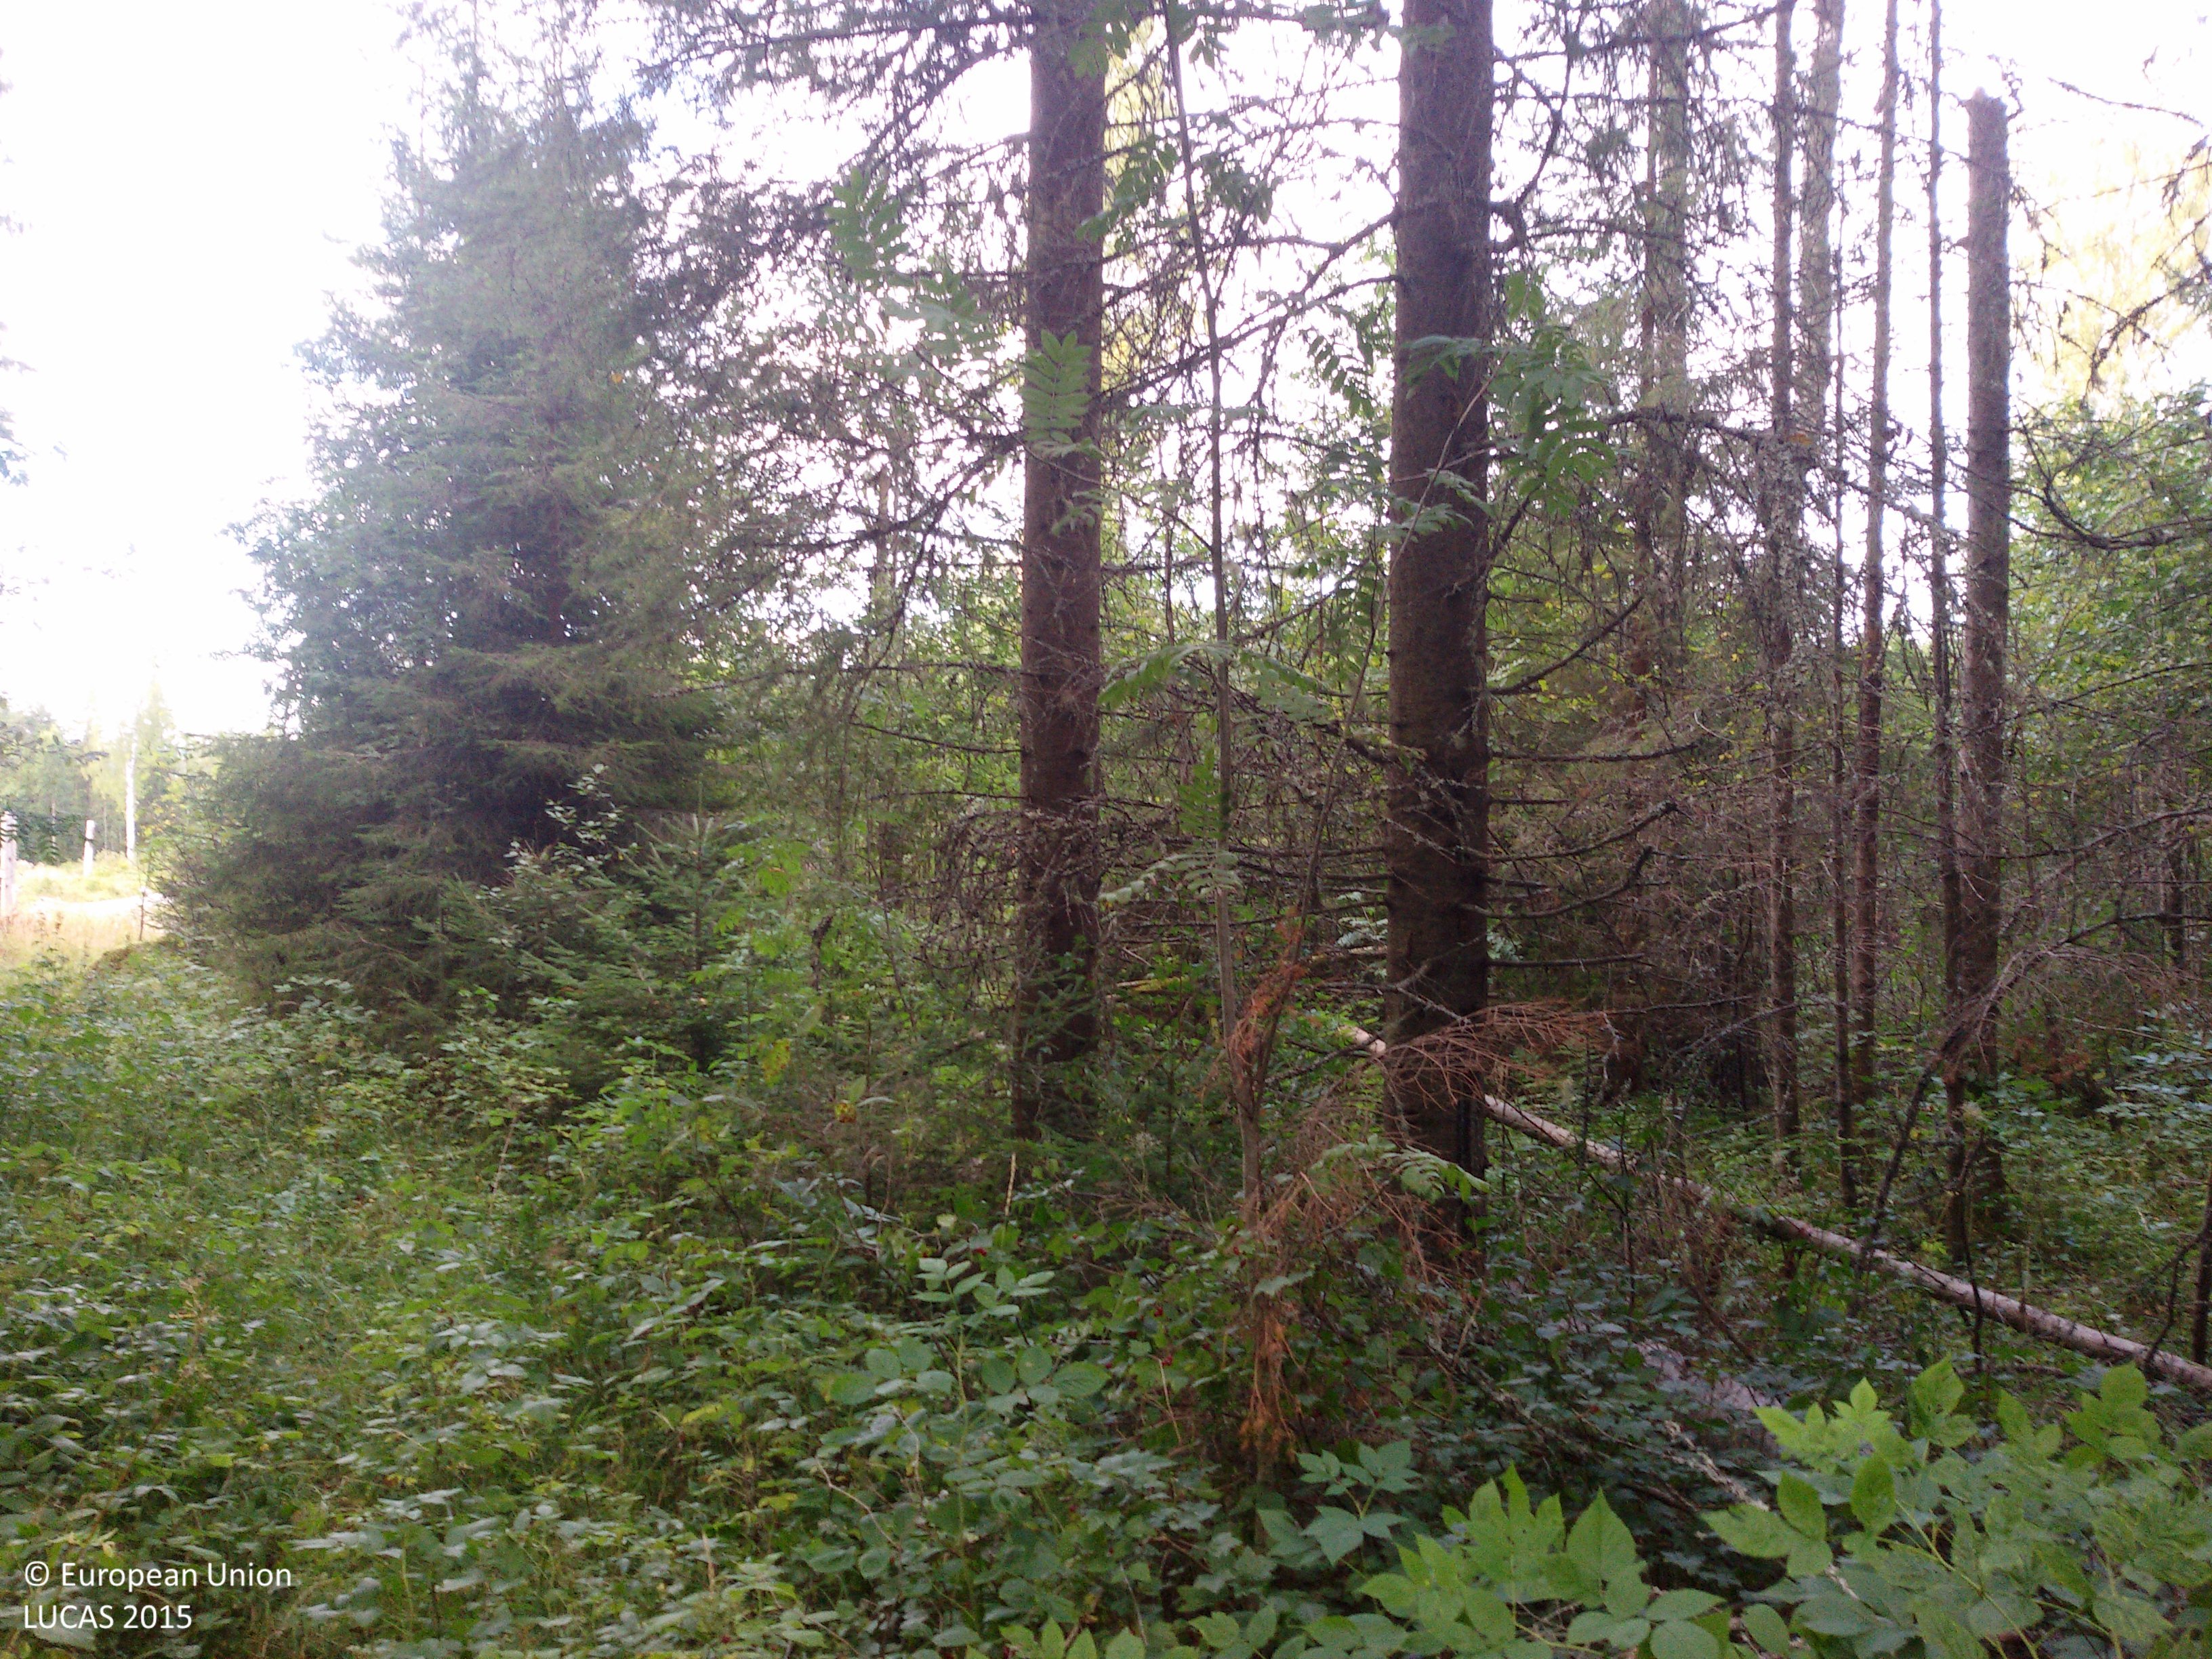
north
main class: Woodland
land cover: Spruce dominated mixed woodland
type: boreal forest
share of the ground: > 75 %
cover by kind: coniferous forest trees 30 %, broadleaved forest trees 30 %, herbaceous plants 25 %, shrubs 10 %, lichens and mosses 5 %
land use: Forestry
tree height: > 5 m
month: September
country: SE
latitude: 60.8303
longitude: 15.0447
